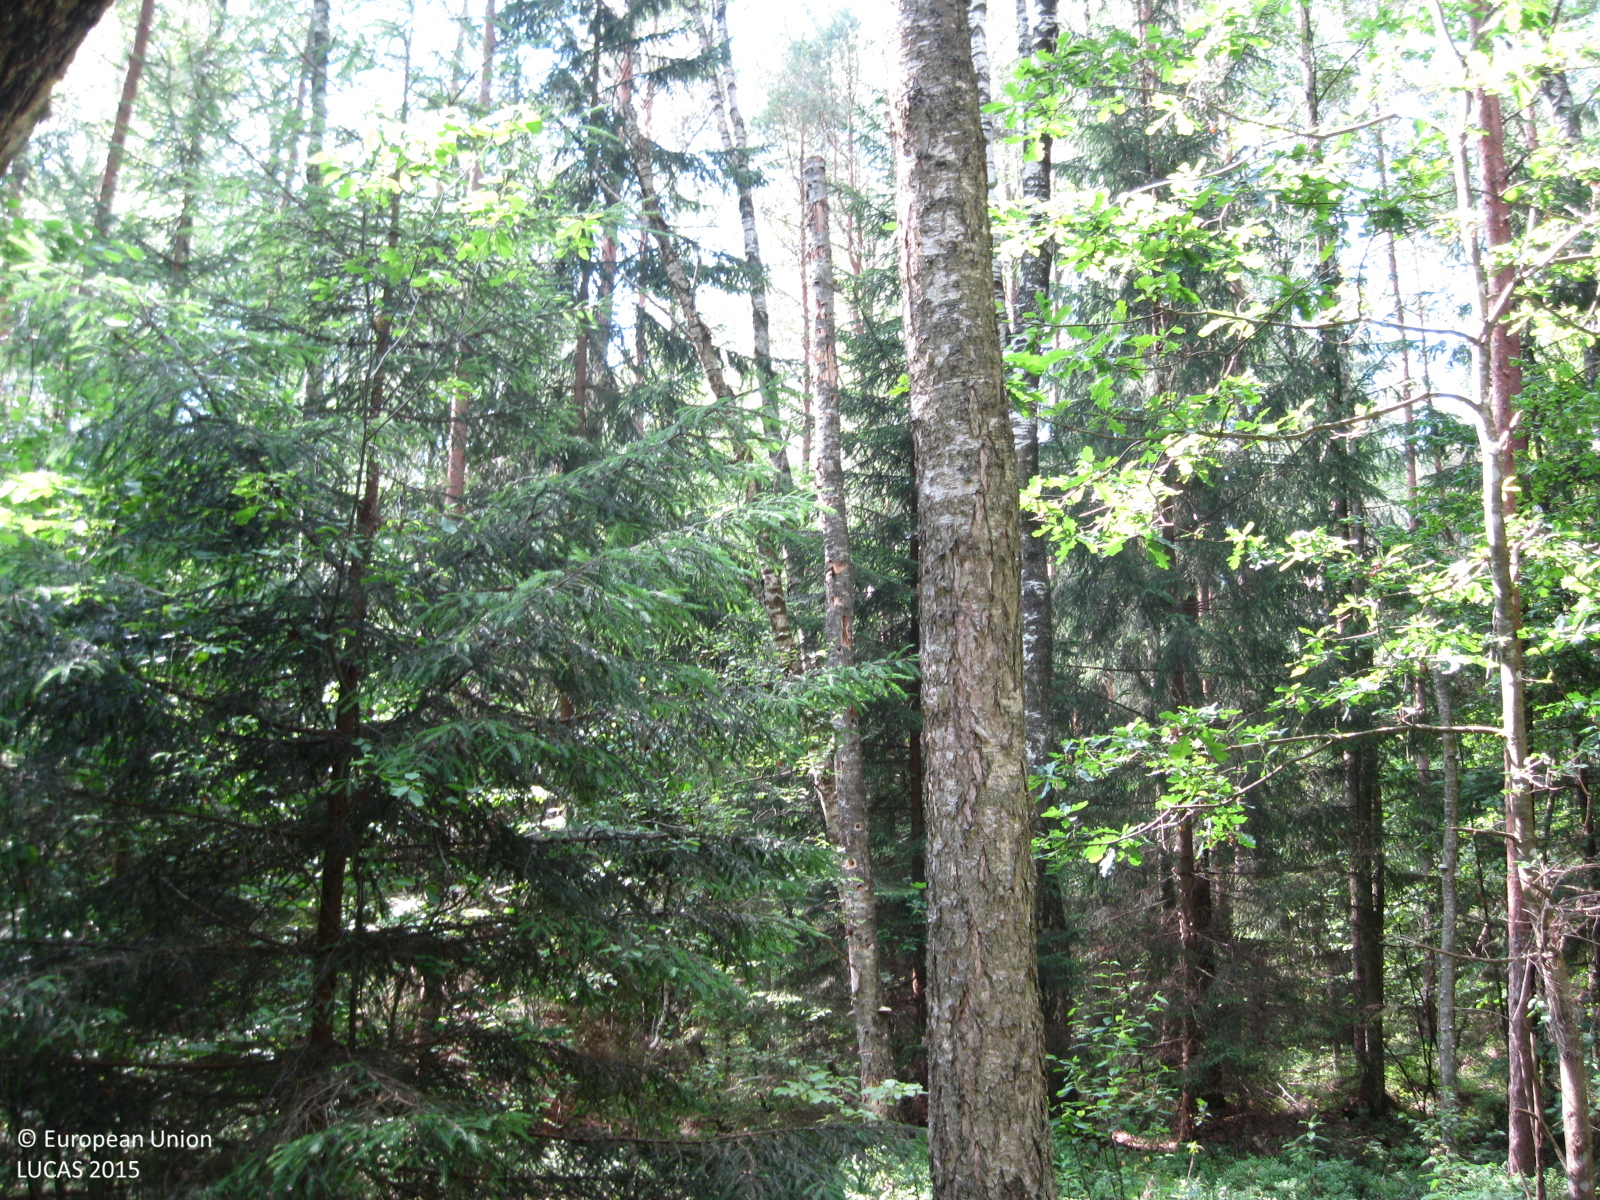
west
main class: Woodland
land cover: Other mixed woodland
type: hemiboreal forest and nemoral coniferous forest and mixed broadleaved-coniferous forest
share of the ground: > 75 %
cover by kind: coniferous forest trees 50 %, broadleaved forest trees 30 %, shrubs 10 %, lichens and mosses 10 %
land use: Forestry
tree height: > 5 m
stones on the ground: < 10 %
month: July
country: LT
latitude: 55.5574
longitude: 24.6735
